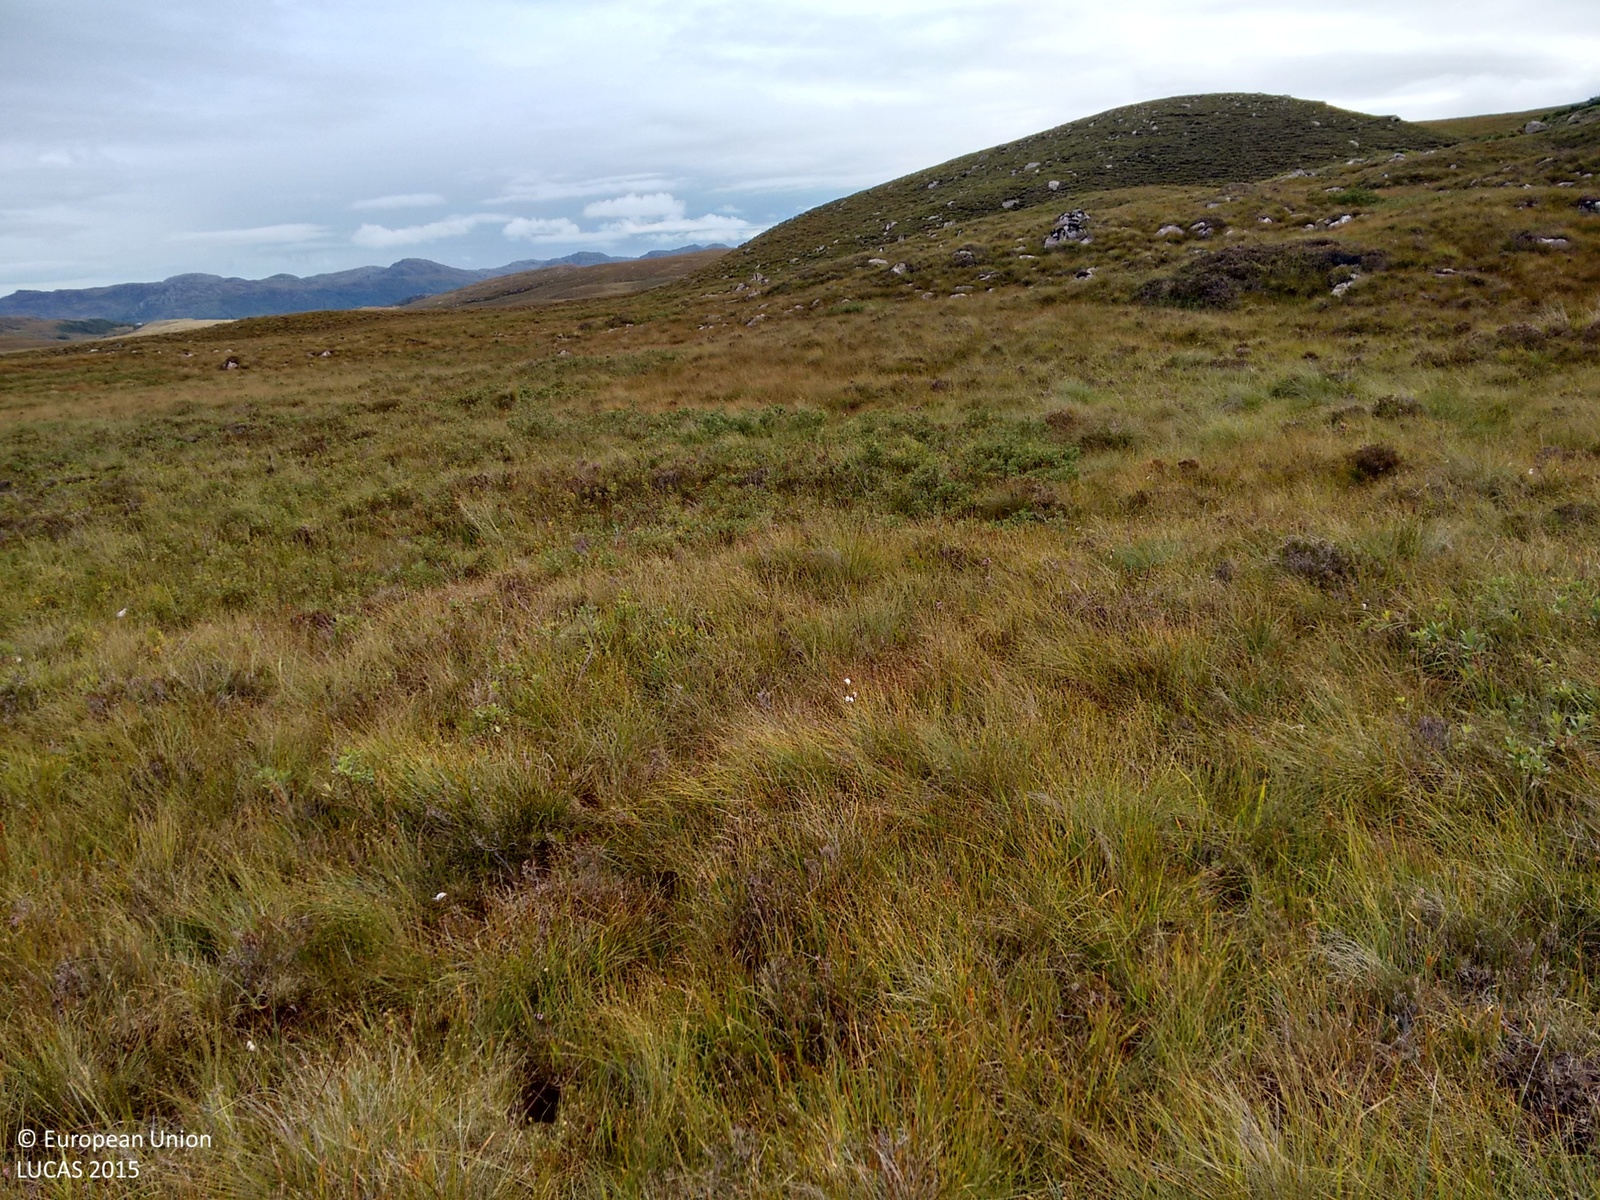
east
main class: Shrubland
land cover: Shrubland without tree cover
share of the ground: > 75 %
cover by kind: herbaceous plants 60 %, shrubs 40 %
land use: Agriculture (excluding fallow land and kitchen gardens)
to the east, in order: Shrubland without tree cover; Rivers and streams; Shrubland without tree cover
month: September
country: GB
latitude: 57.6841
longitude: -5.7691
